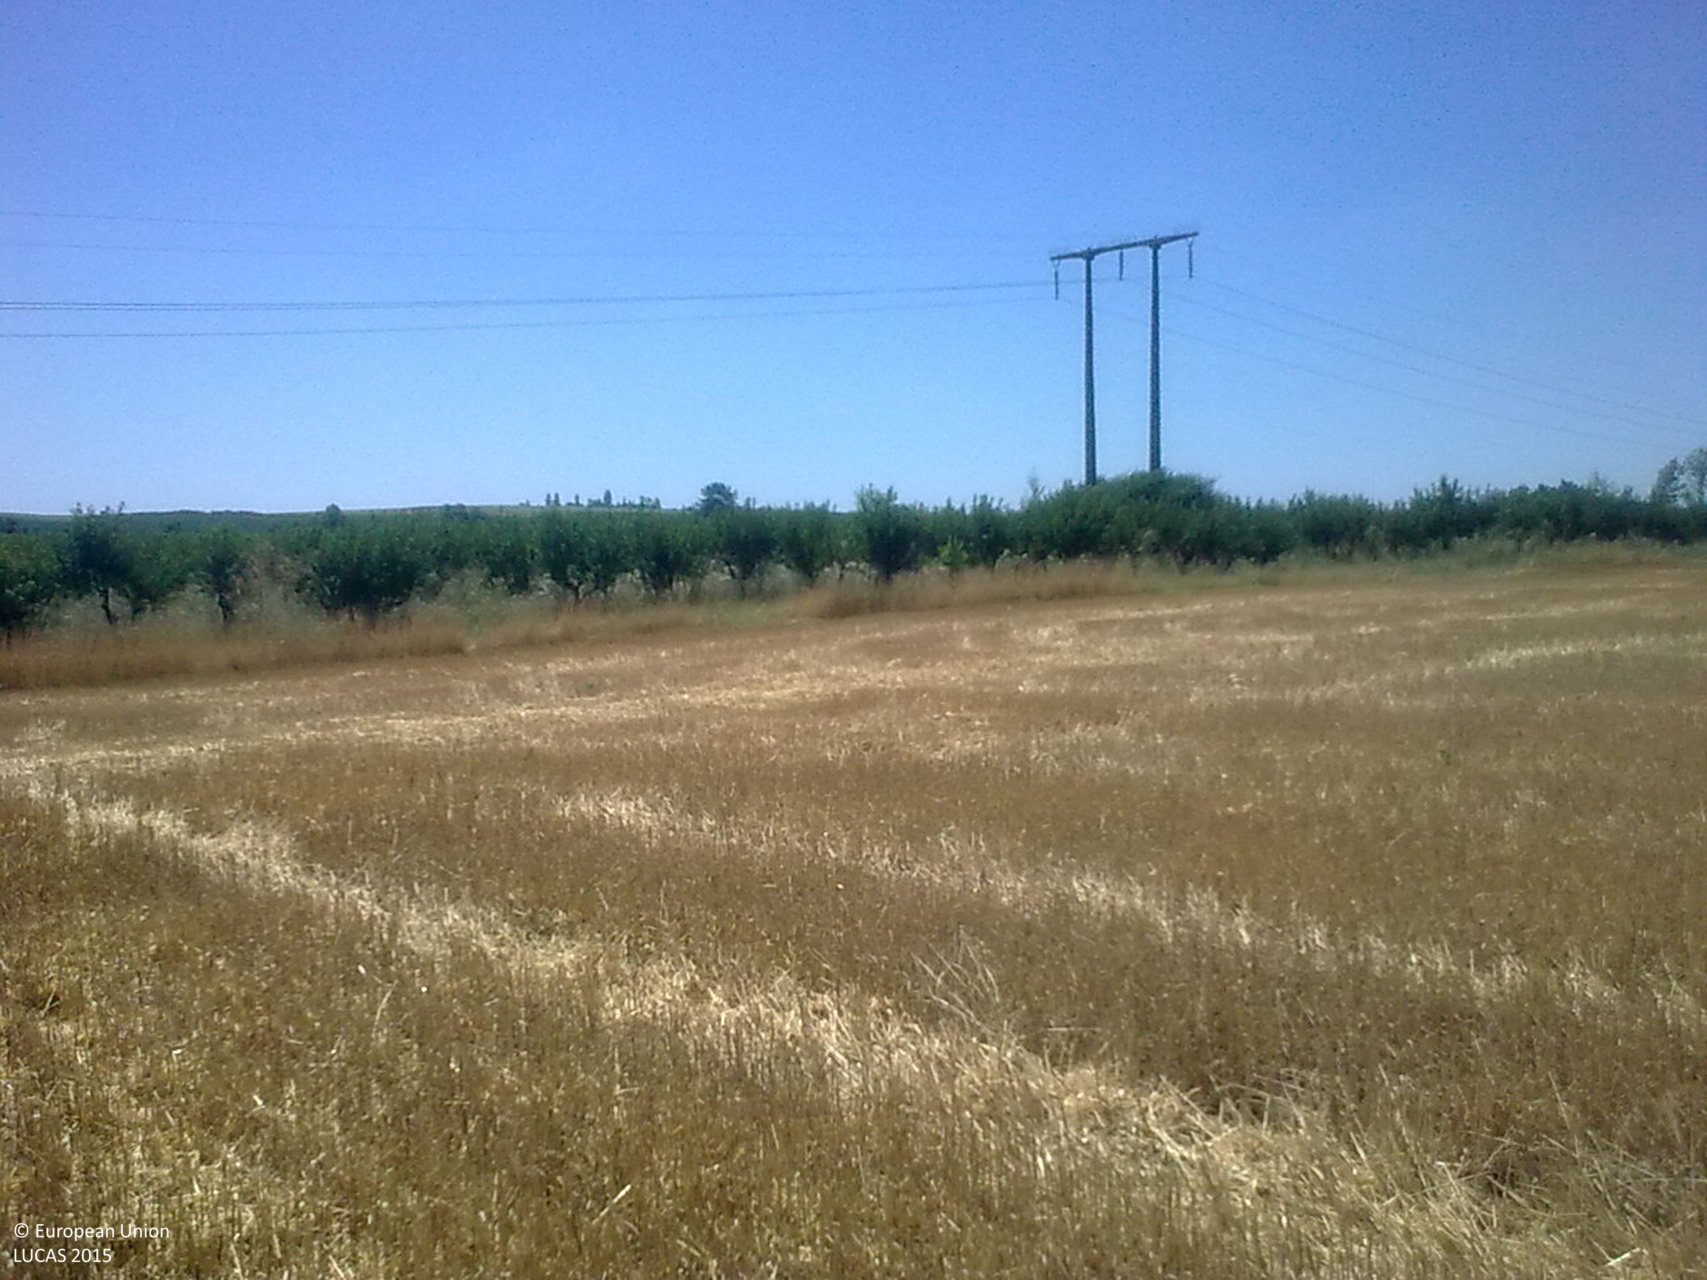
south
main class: Cropland
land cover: Common wheat
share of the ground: 50 - 75 %
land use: Agriculture (excluding fallow land and kitchen gardens)
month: July
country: BG
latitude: 43.9001
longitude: 26.2762
